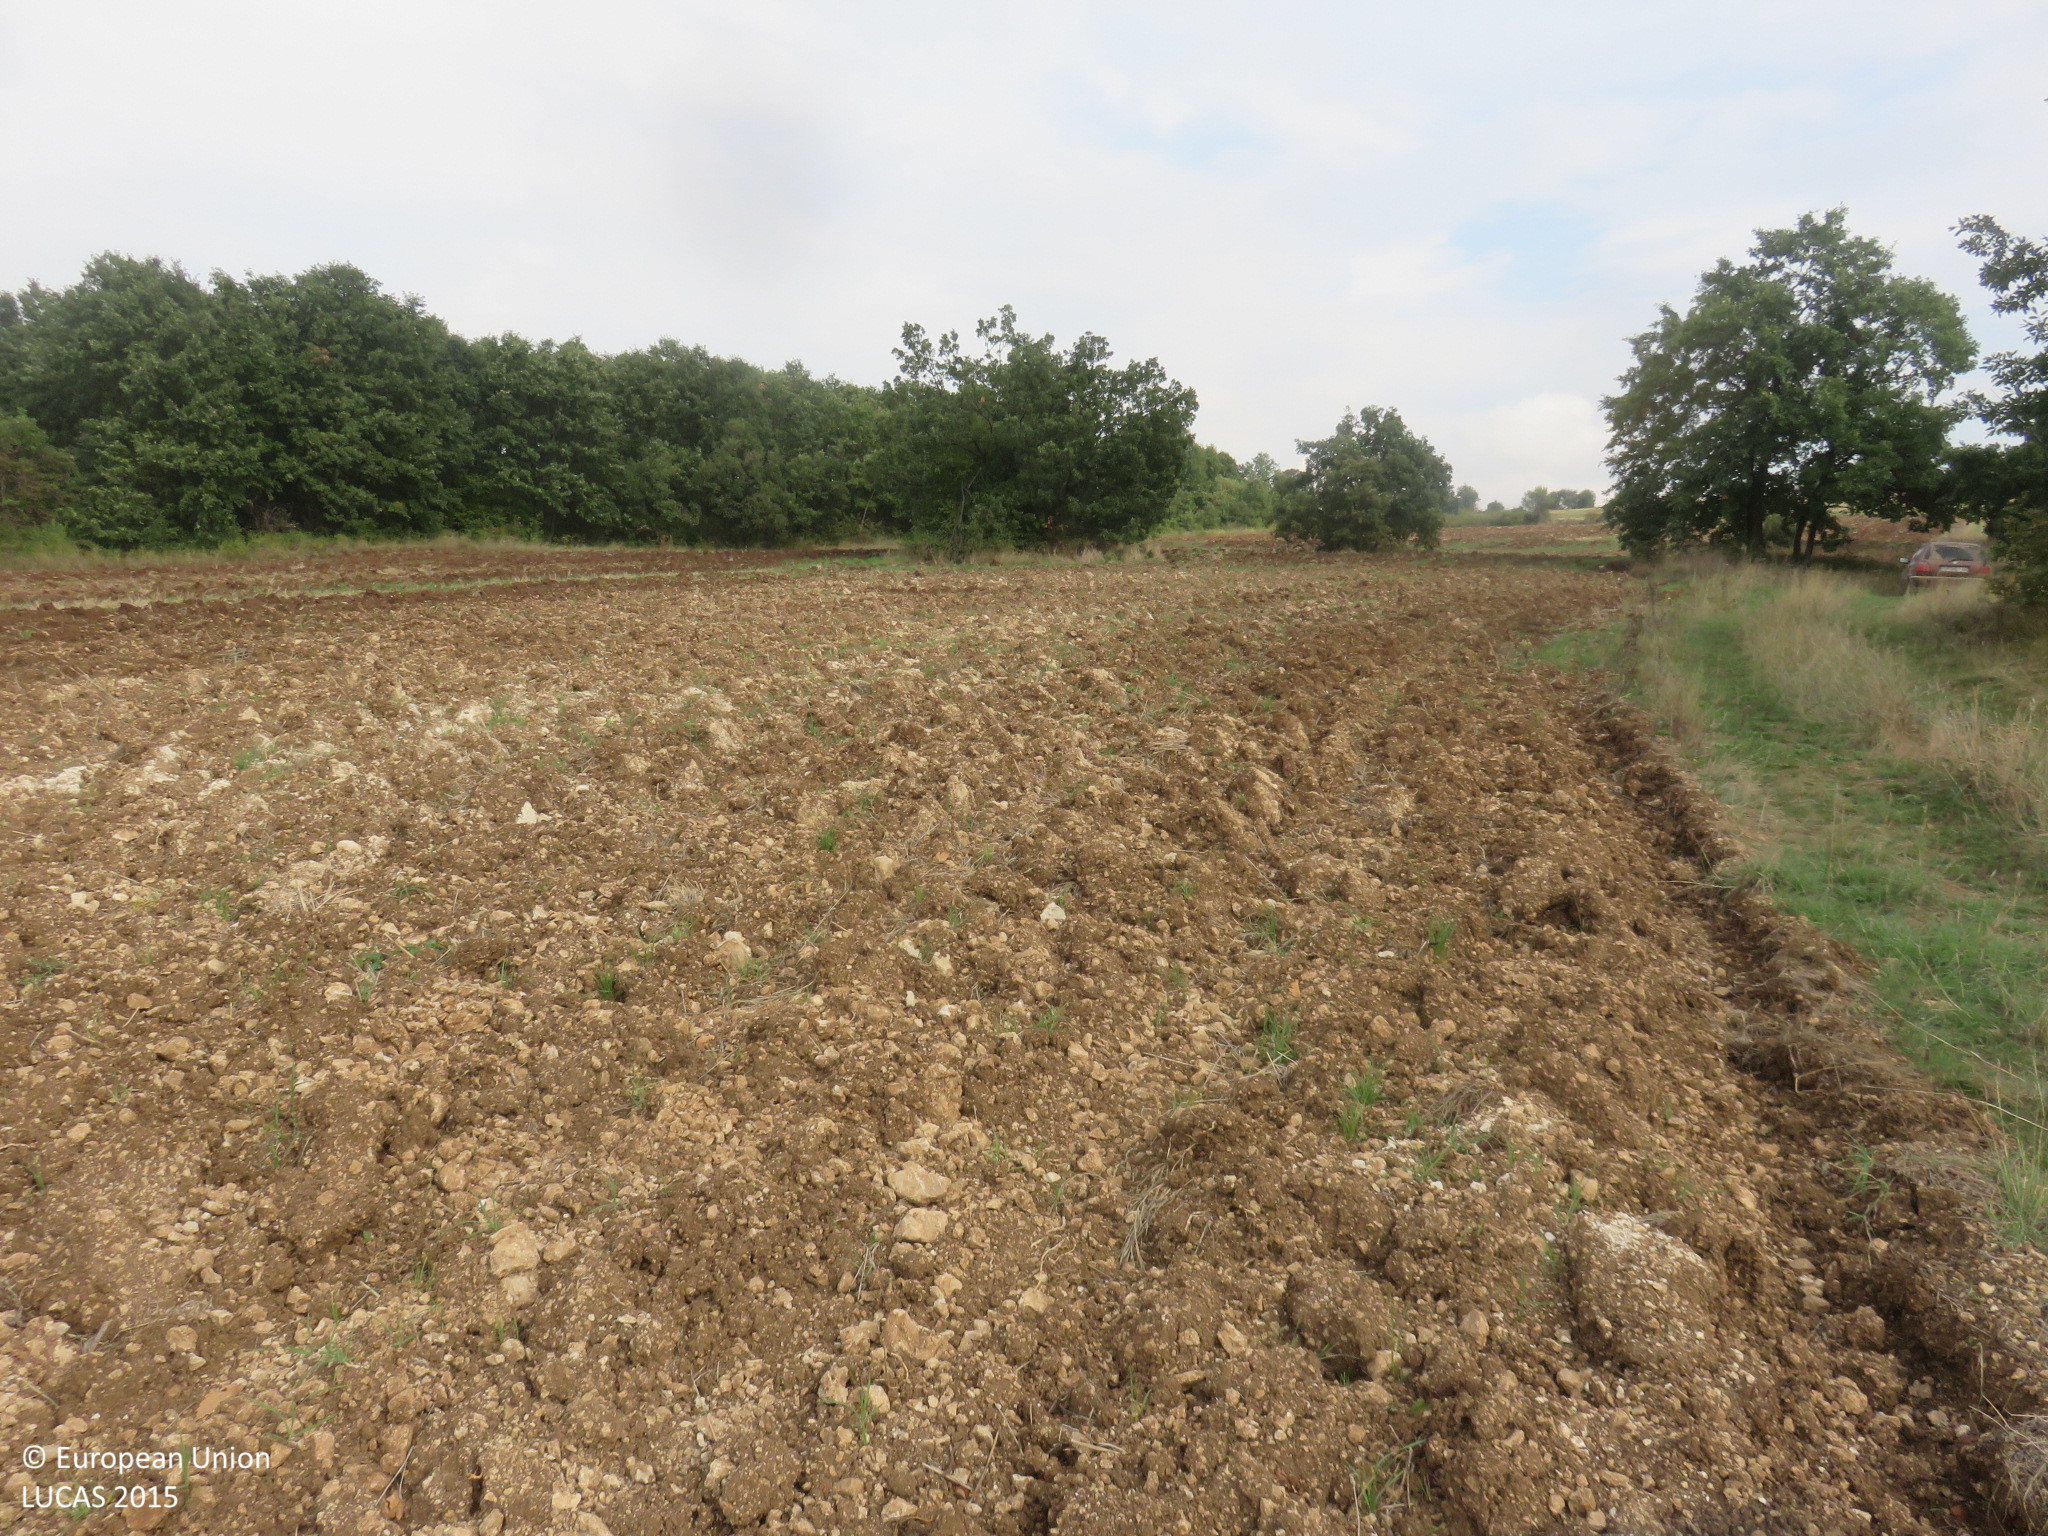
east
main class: Cropland
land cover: Common wheat
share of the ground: < 10 %
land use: Agriculture (excluding fallow land and kitchen gardens)
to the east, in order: Common wheat; Broadleaved woodland
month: September
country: BG
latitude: 43.1564
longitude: 24.9094
